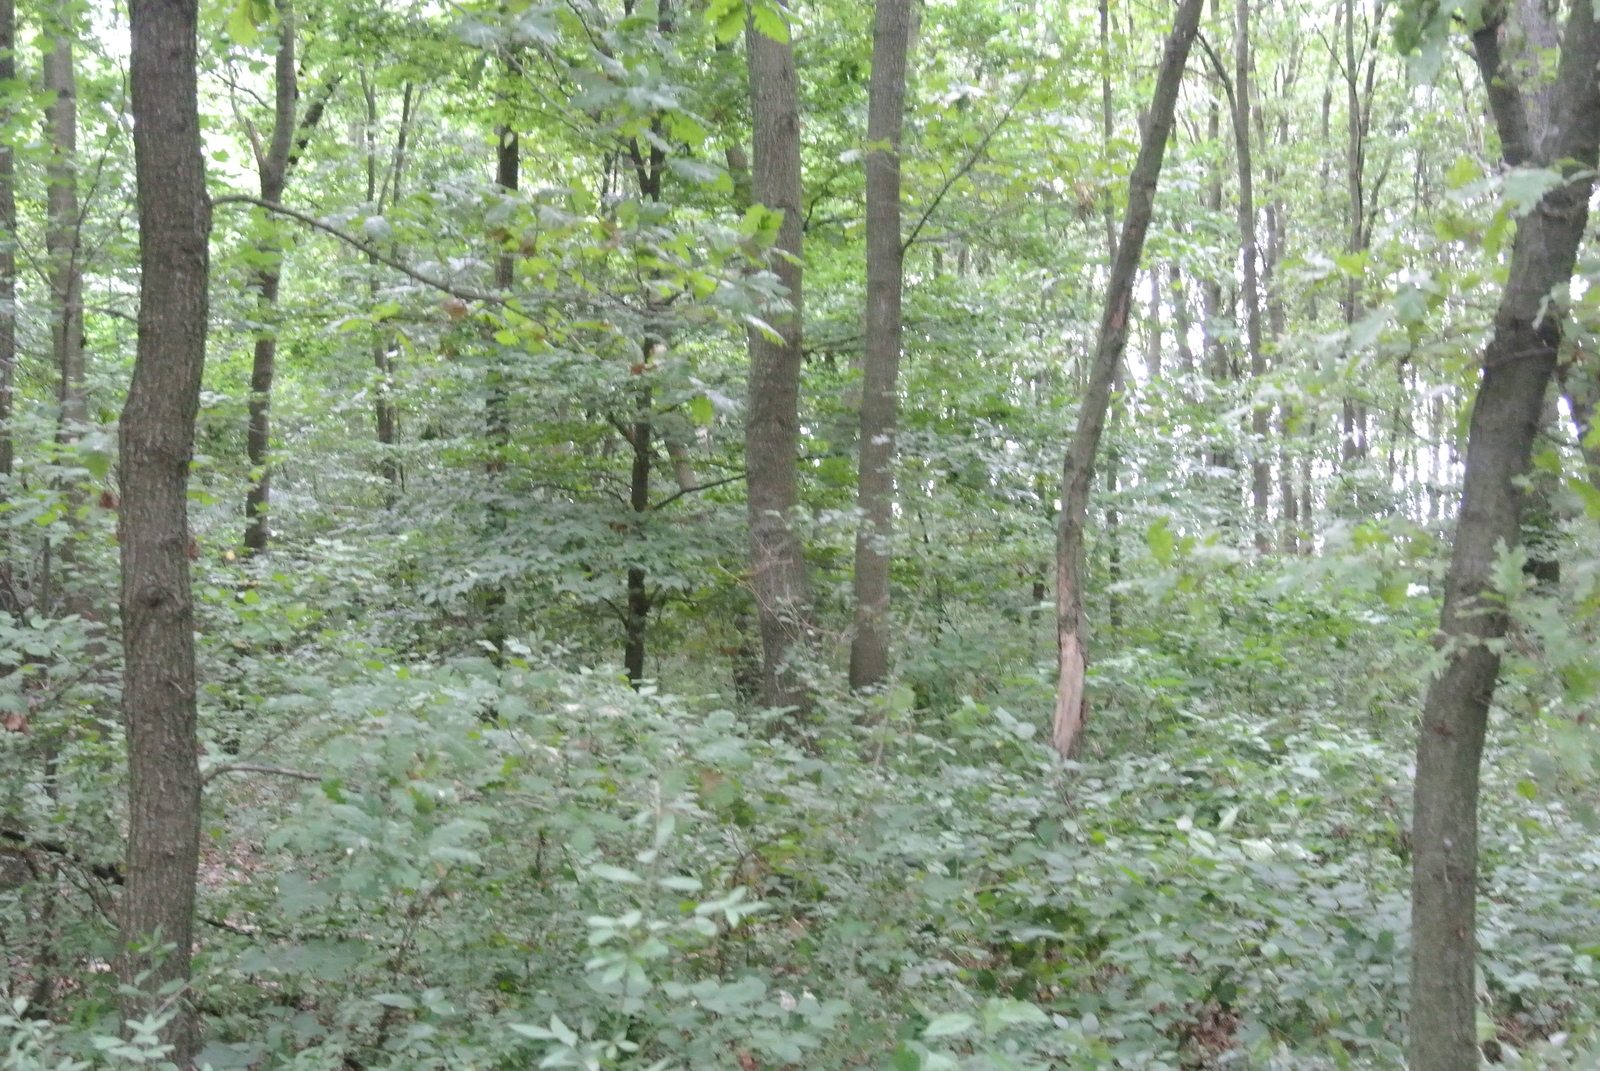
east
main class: Woodland
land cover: Broadleaved woodland
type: mesophytic deciduous forest
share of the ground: > 75 %
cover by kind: broadleaved forest trees 90 %, shrubs 10 %
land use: Forestry
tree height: > 5 m
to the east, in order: Broadleaved woodland; Tracks; Grass margins; Other bare soil; Grass margins; Tracks; Grass margins; Soya
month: July
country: AT
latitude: 47.5573
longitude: 16.5826
